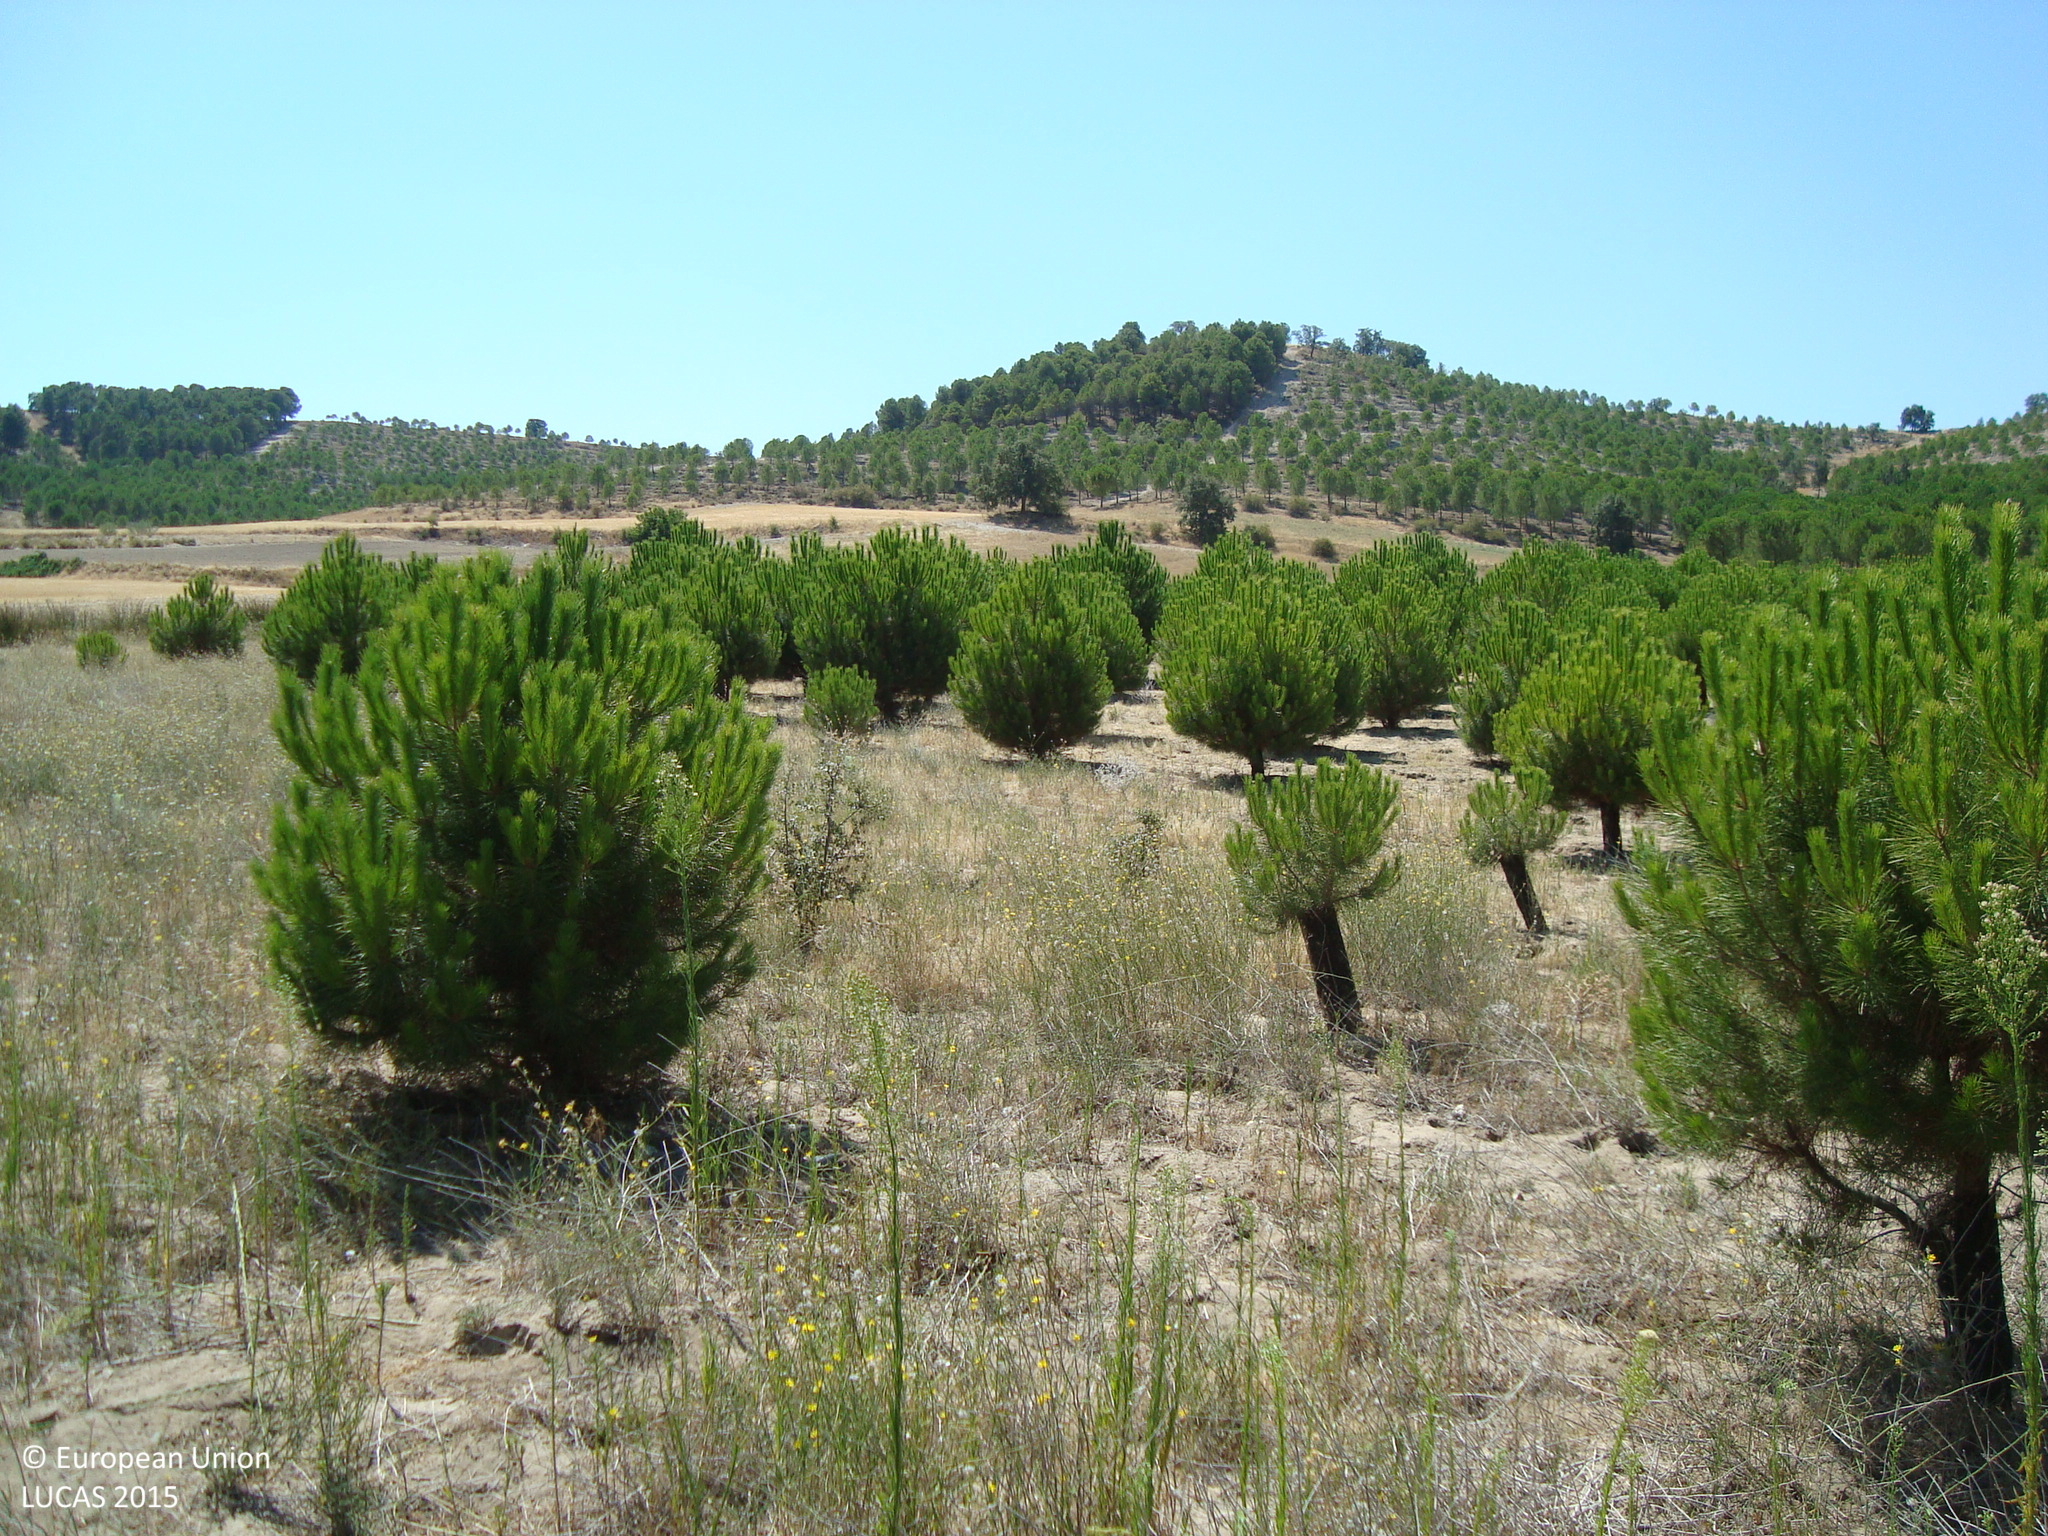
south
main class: Woodland
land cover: Pine dominated coniferous woodland
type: coniferous forest of the mediterranean region
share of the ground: 25 - 50 %
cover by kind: herbaceous plants 60 %, coniferous forest trees 40 %
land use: Forestry
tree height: < 5 m
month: August
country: ES
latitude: 41.4066
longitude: -4.5980
